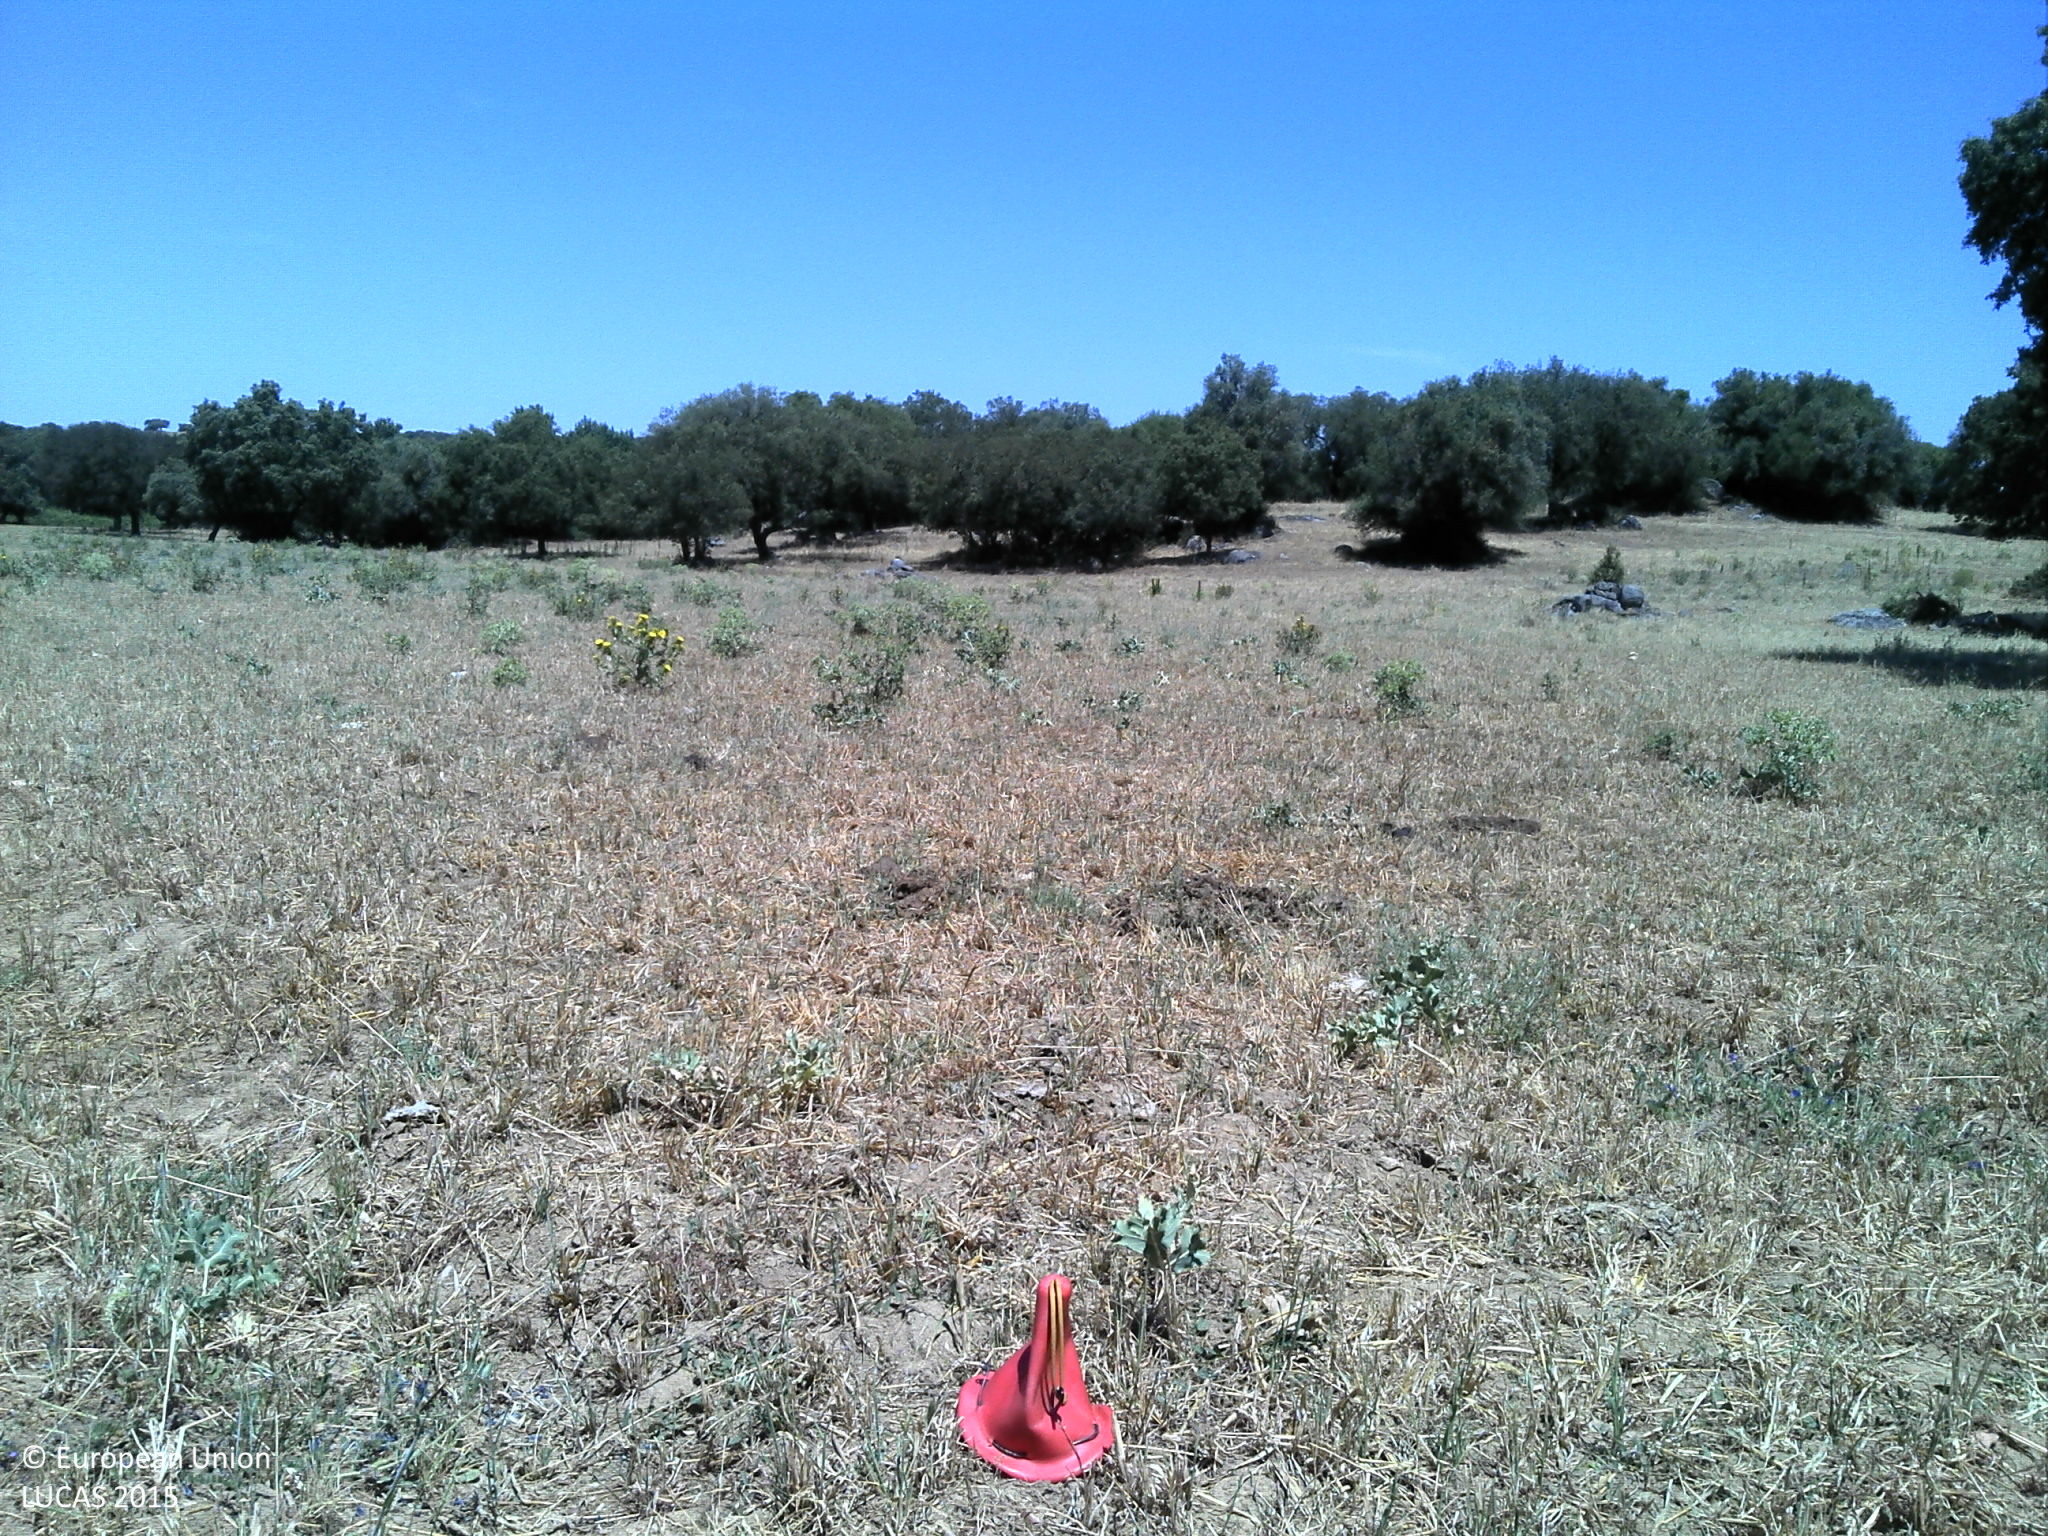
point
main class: Woodland
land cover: Broadleaved woodland
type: broadleaved evergreen forest
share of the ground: 25 - 50 %
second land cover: Grassland without tree/shrub cover
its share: 25 - 50 %
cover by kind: unconsolidated bare surface 50 %, broadleaved forest trees 25 %, herbaceous plants 25 %
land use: Forestry
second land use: Agriculture (excluding fallow land and kitchen gardens)
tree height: > 5 m
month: June
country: PT
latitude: 38.7901
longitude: -7.8053
